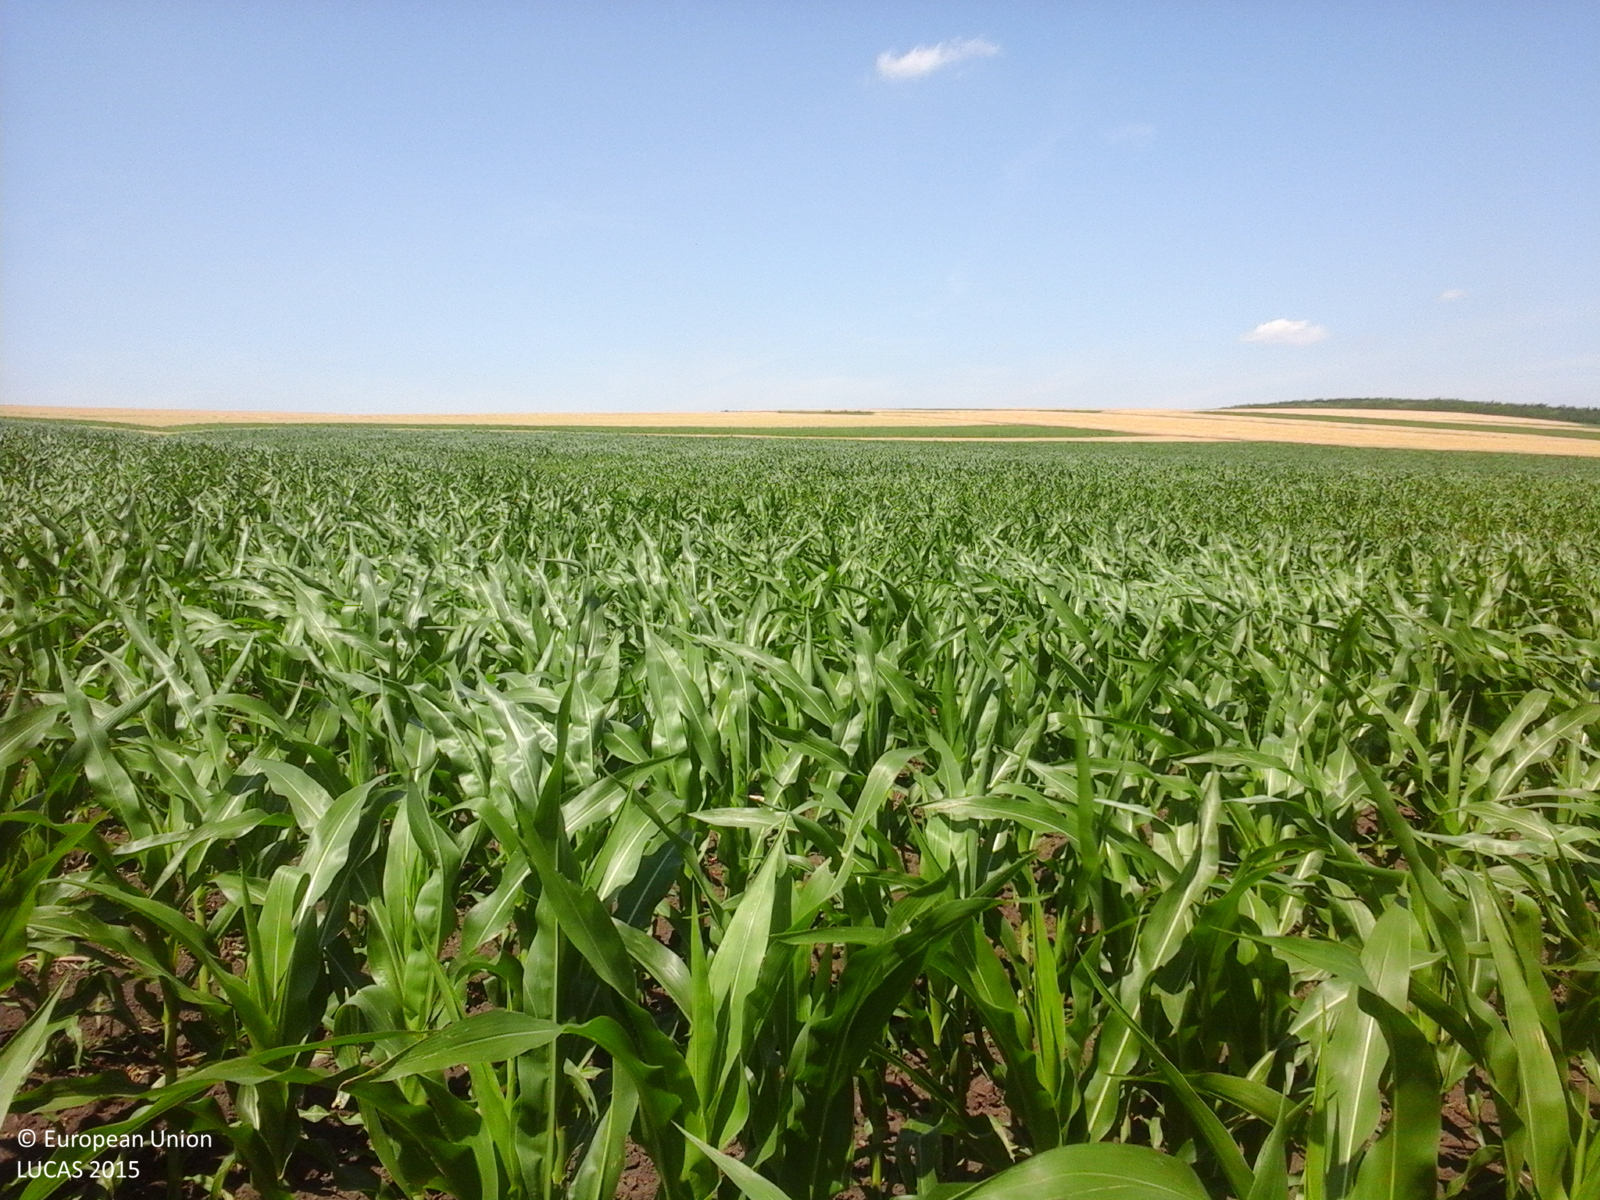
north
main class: Cropland
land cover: Maize
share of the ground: > 75 %
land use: Agriculture (excluding fallow land and kitchen gardens)
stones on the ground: < 10 %
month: June
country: RO
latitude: 47.7244
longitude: 27.1885
